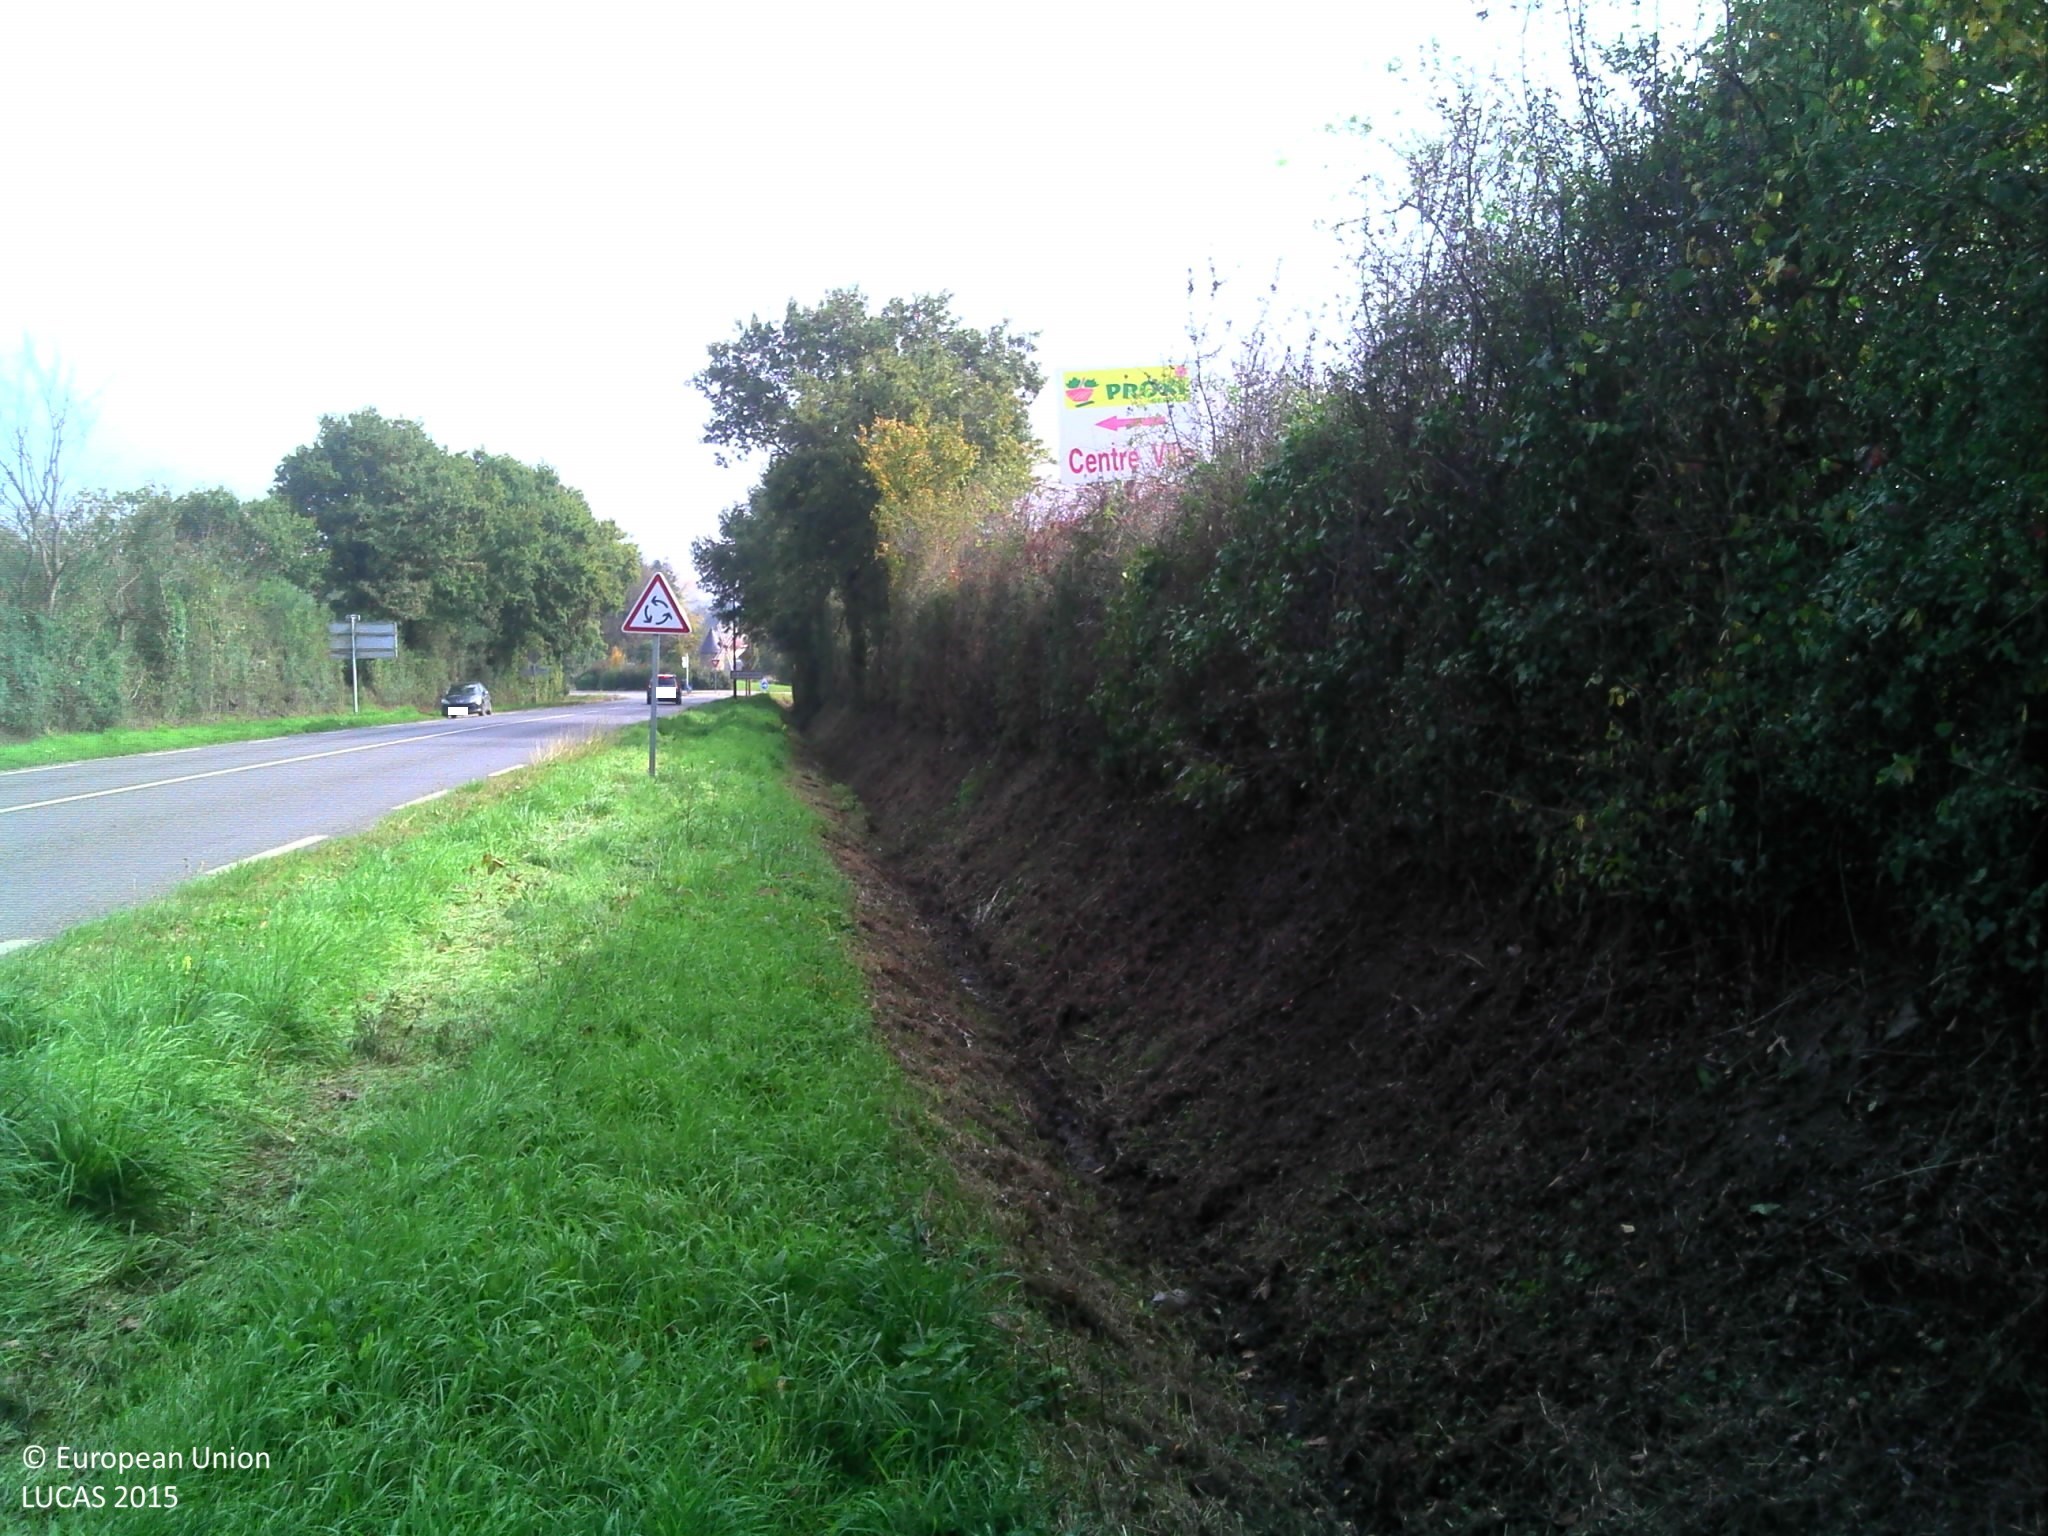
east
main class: Grassland
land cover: Grassland without tree/shrub cover
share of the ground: > 75 %
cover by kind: herbaceous plants 100 %
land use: Road transport
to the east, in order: Grassland without tree/shrub cover; Ditches and canals; Managed hedges; Electric lines; Maize; Grass margins; Broadleaved woodland; Spontaneously vegetated surfaces; Grass margins; Paved roads, cycling and walking lanes; Grass margins; Ditches and canals; Broadleaved woodland; Fences; Grassland without tree/shrub cover
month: October
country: FR
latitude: 47.0591
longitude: -0.9483
